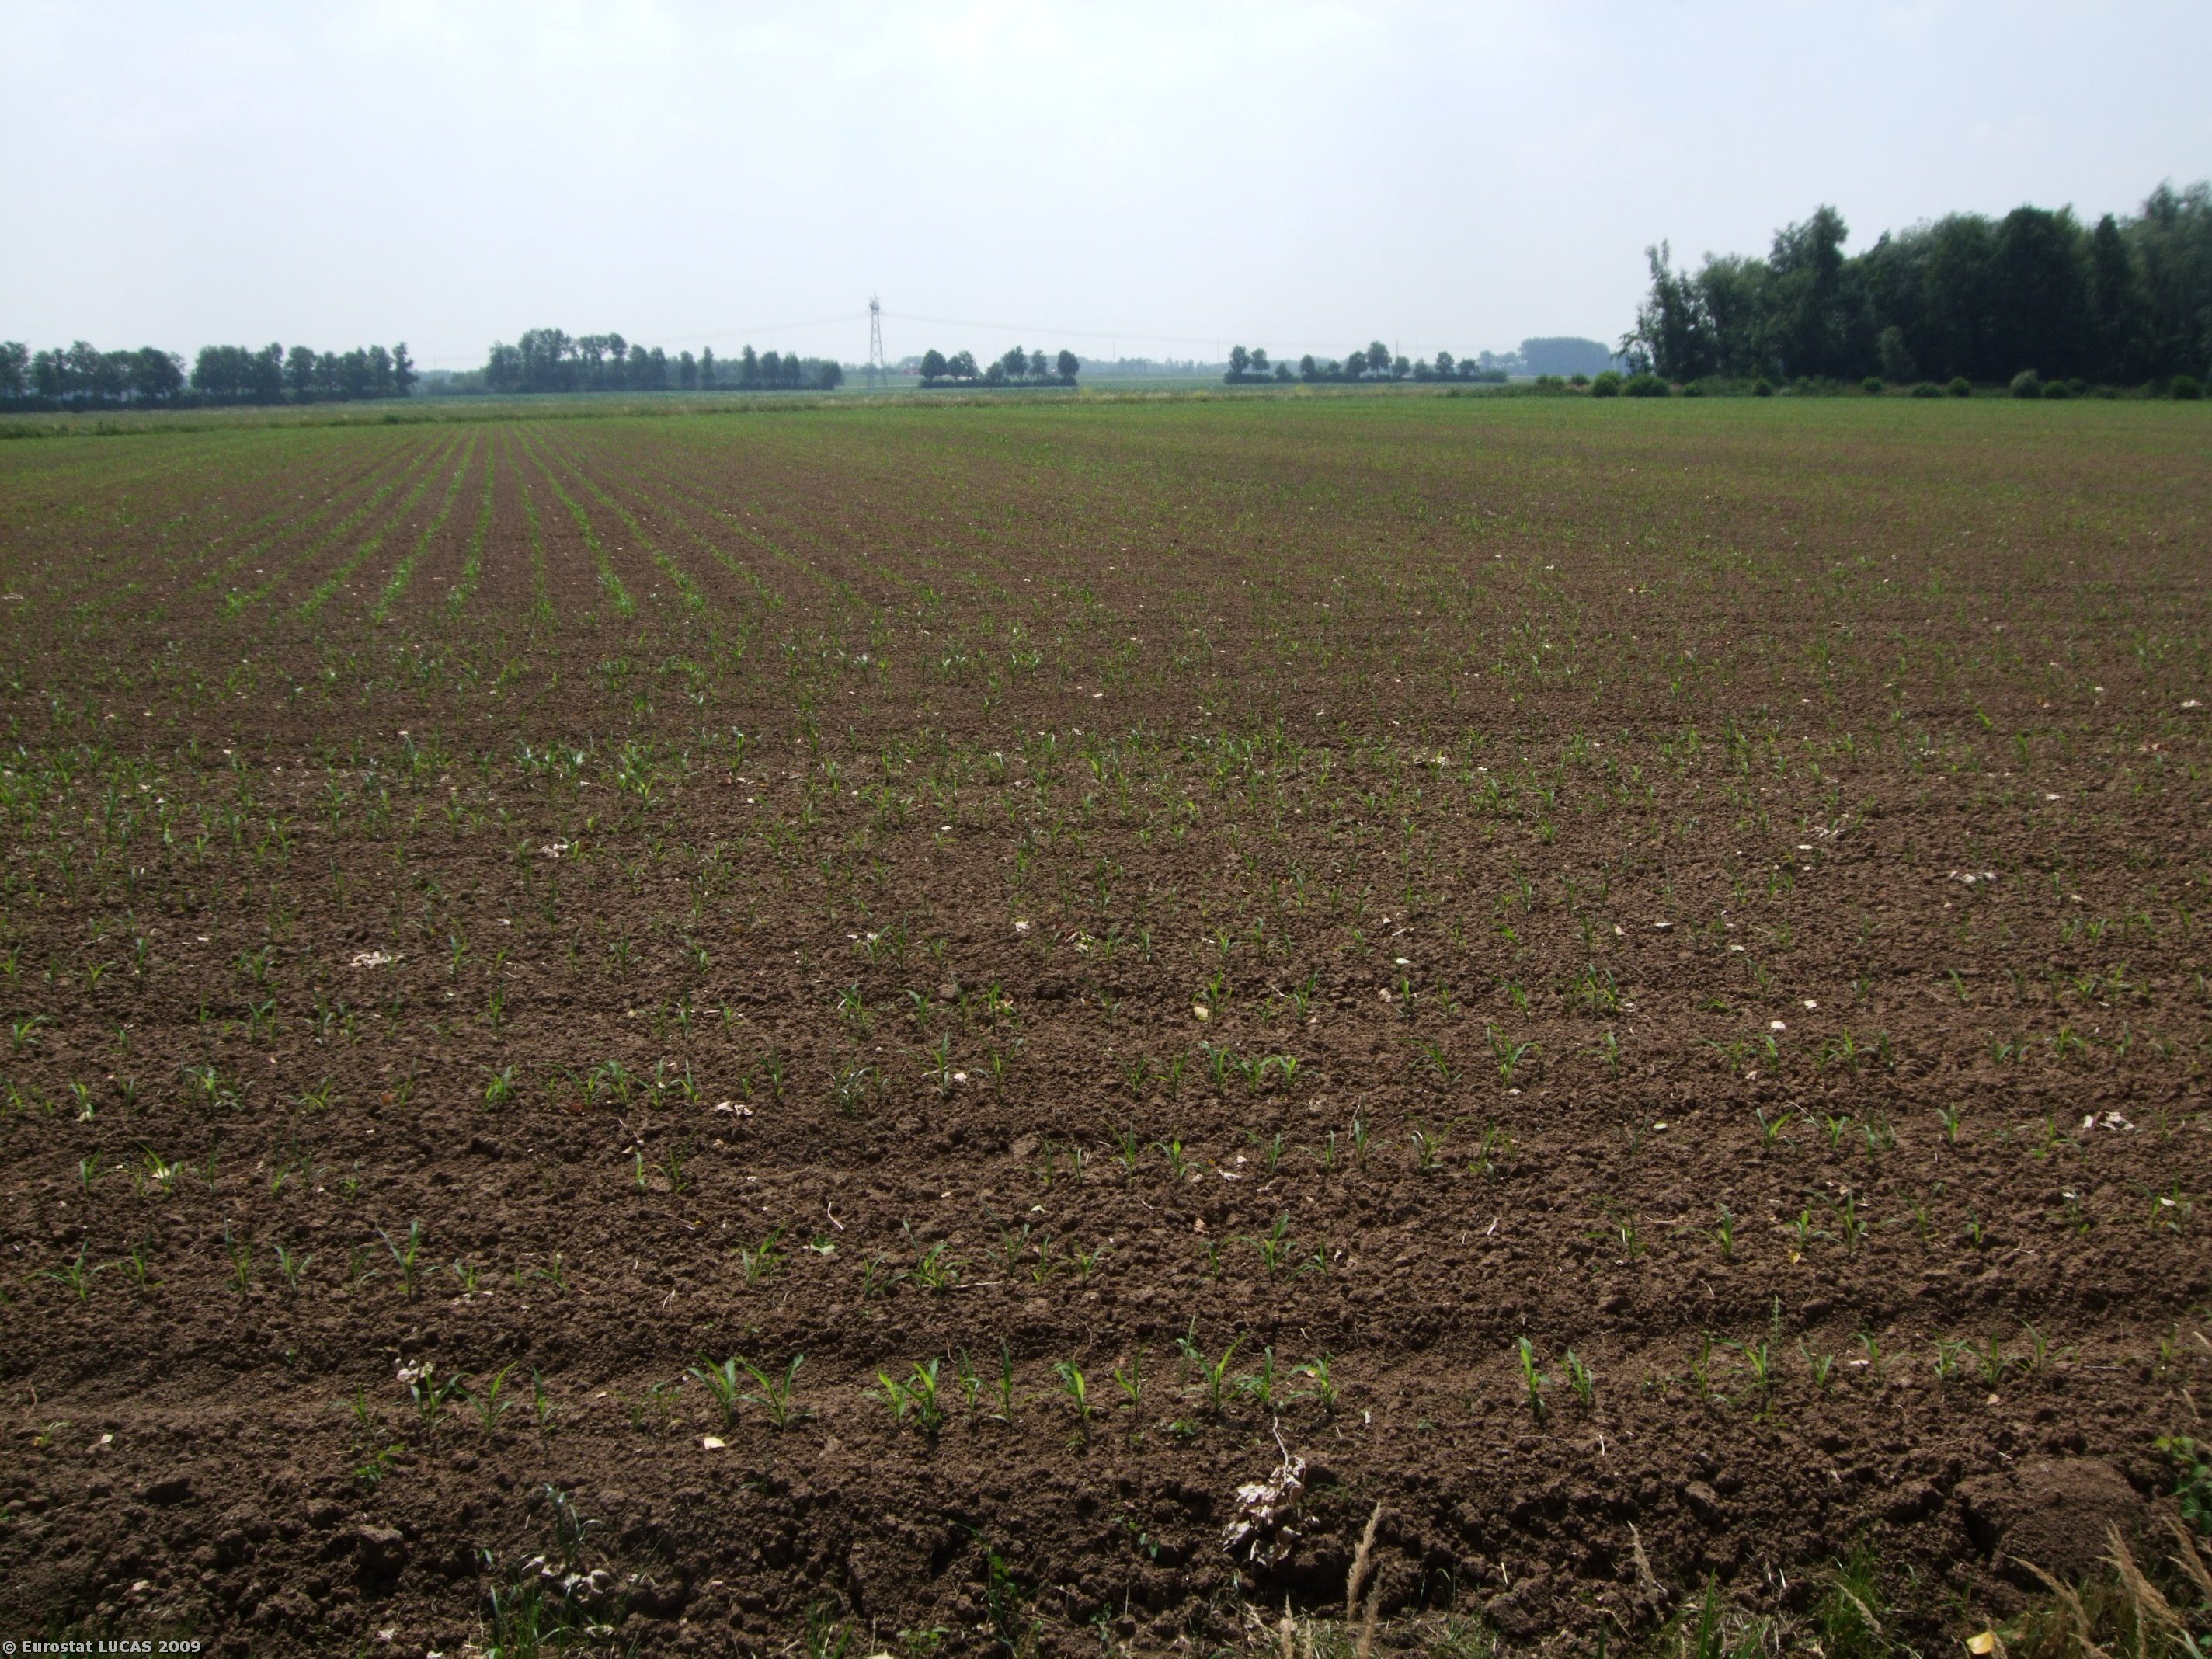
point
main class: Cropland
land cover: Maize
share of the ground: < 10 %
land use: Agriculture (excluding fallow land and kitchen gardens)
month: July
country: NL
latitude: 51.8681
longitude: 5.7143
